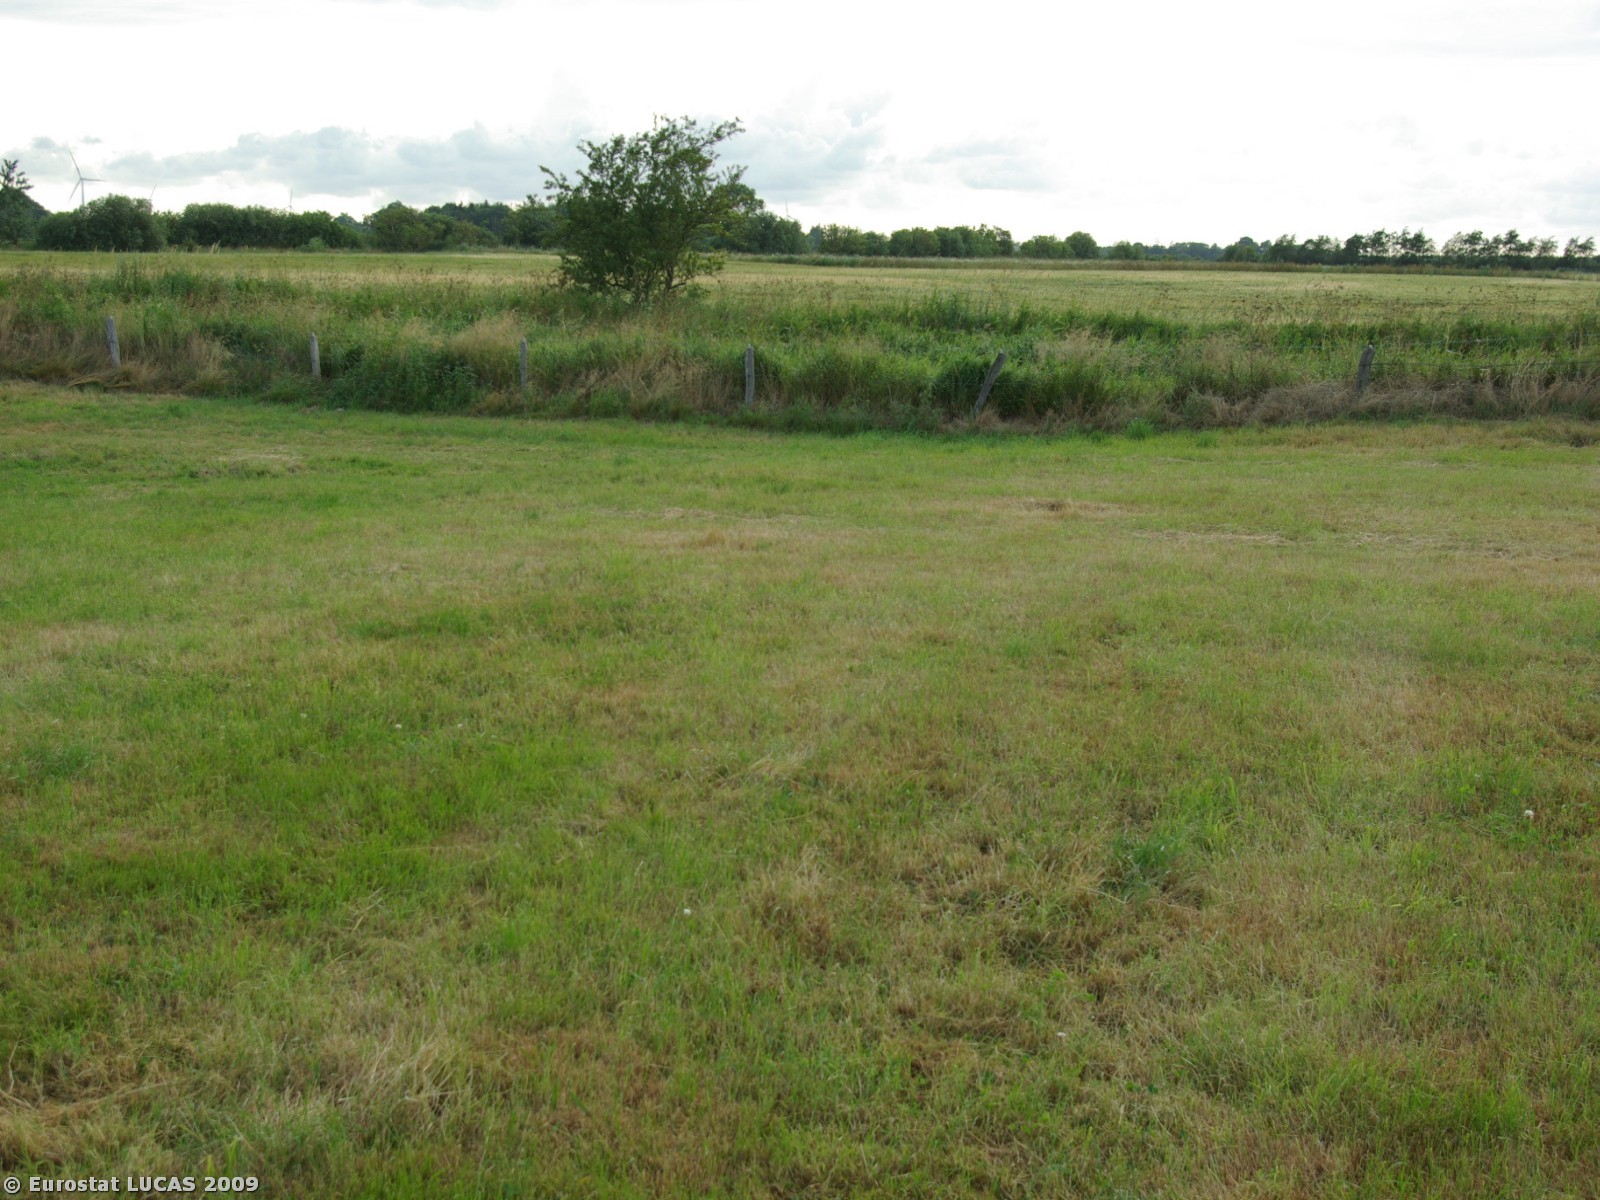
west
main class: Grassland
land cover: Grassland without tree/shrub cover
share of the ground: > 75 %
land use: Agriculture (excluding fallow land and kitchen gardens)
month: July
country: DK
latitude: 54.9077
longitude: 9.0181
